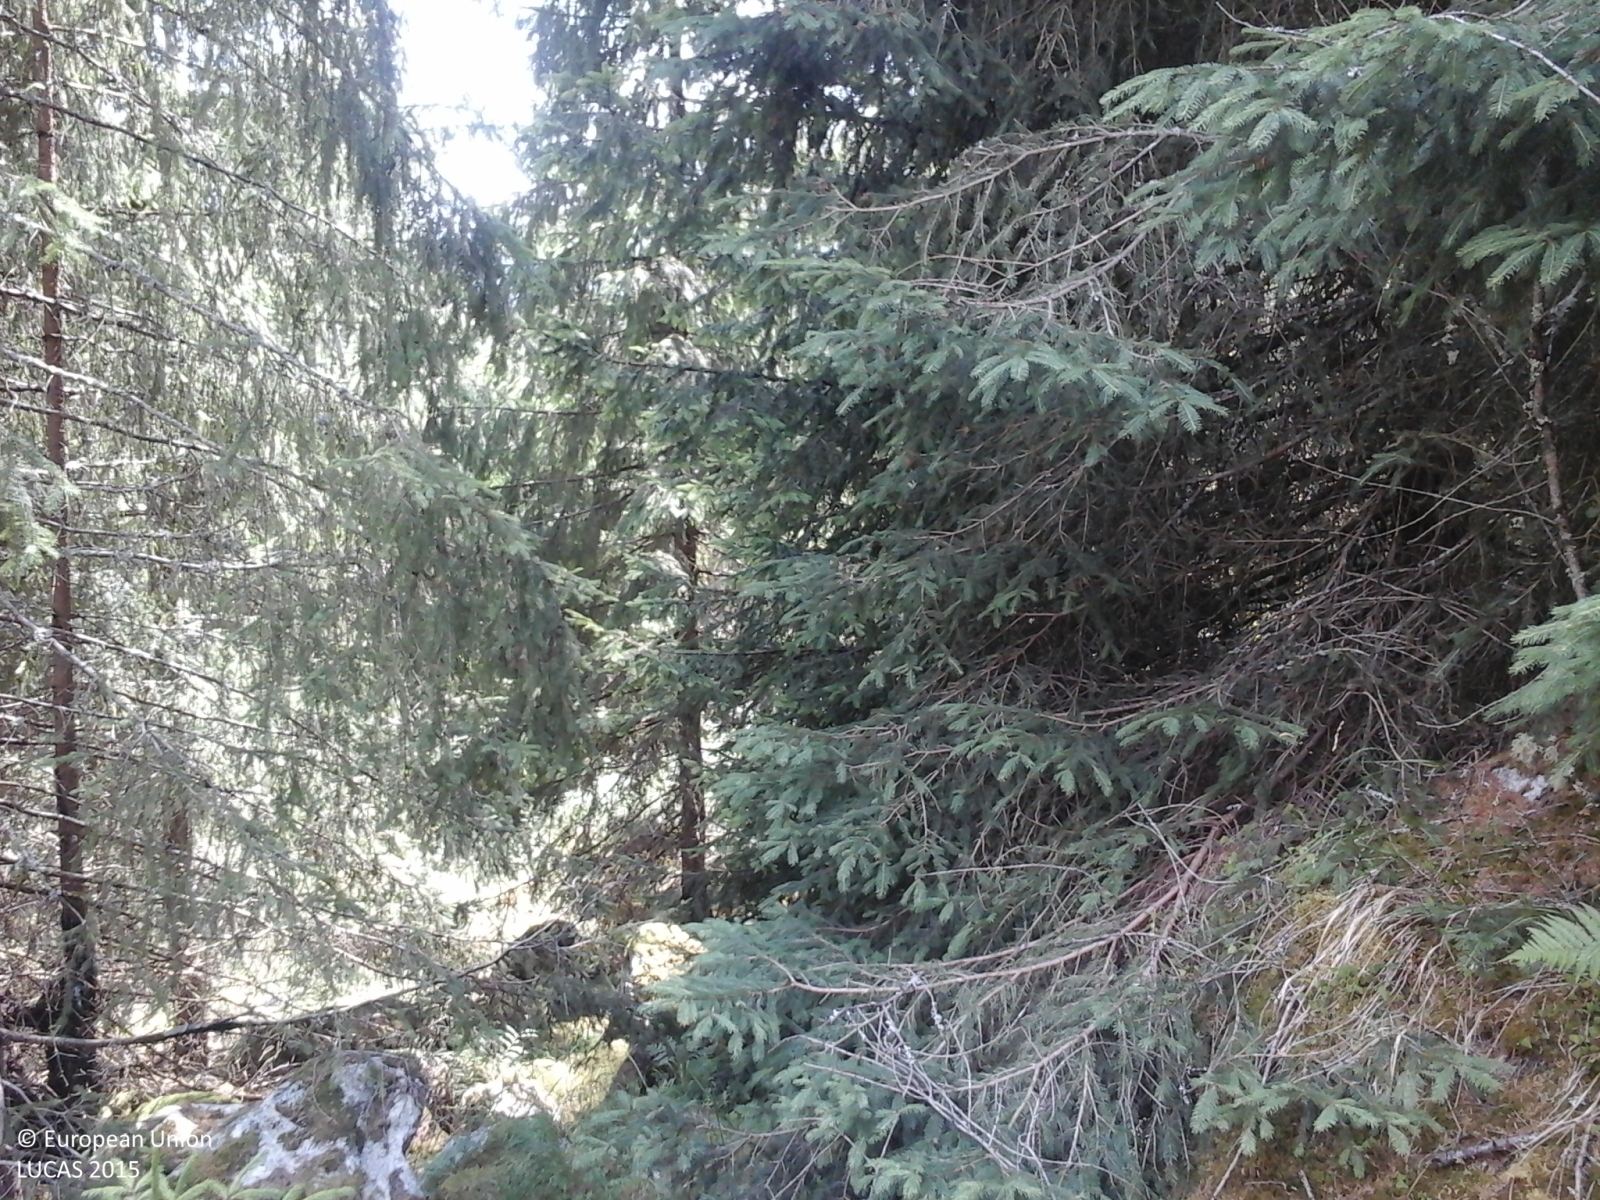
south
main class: Woodland
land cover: Spruce dominated coniferous woodland
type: alpine coniferous forest
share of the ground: > 75 %
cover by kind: coniferous forest trees 100 %
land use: Semi-natural and natural areas not in use
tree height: > 5 m
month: July
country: IT
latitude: 46.8614
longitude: 11.6118
